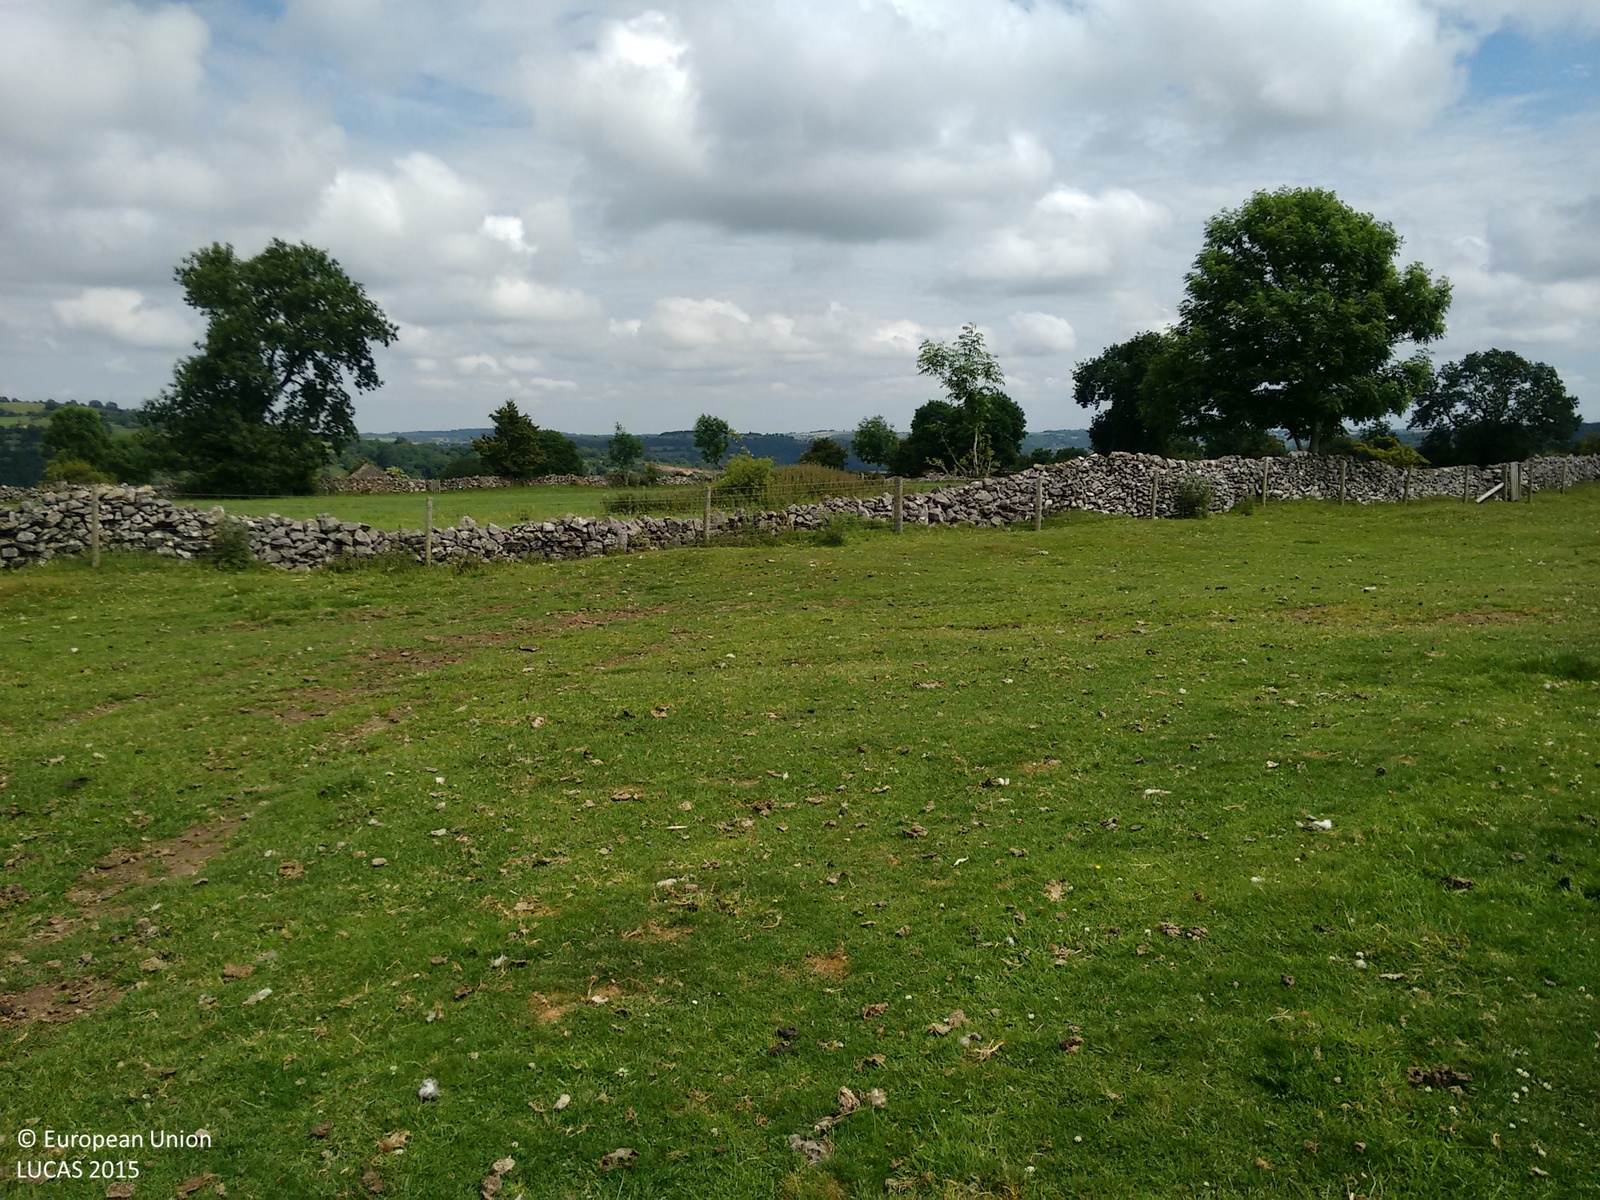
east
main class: Grassland
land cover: Grassland without tree/shrub cover
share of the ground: > 75 %
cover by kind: herbaceous plants 100 %
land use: Agriculture (excluding fallow land and kitchen gardens)
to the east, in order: Grassland without tree/shrub cover; Fences; Dry stone walls; Grassland without tree/shrub cover; Dry stone walls; Grassland without tree/shrub cover; Dry stone walls; Single bushes/trees; Grassland without tree/shrub cover; Dry stone walls; Fences; Grassland without tree/shrub cover
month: July
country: GB
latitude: 53.1148
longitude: -1.6007
